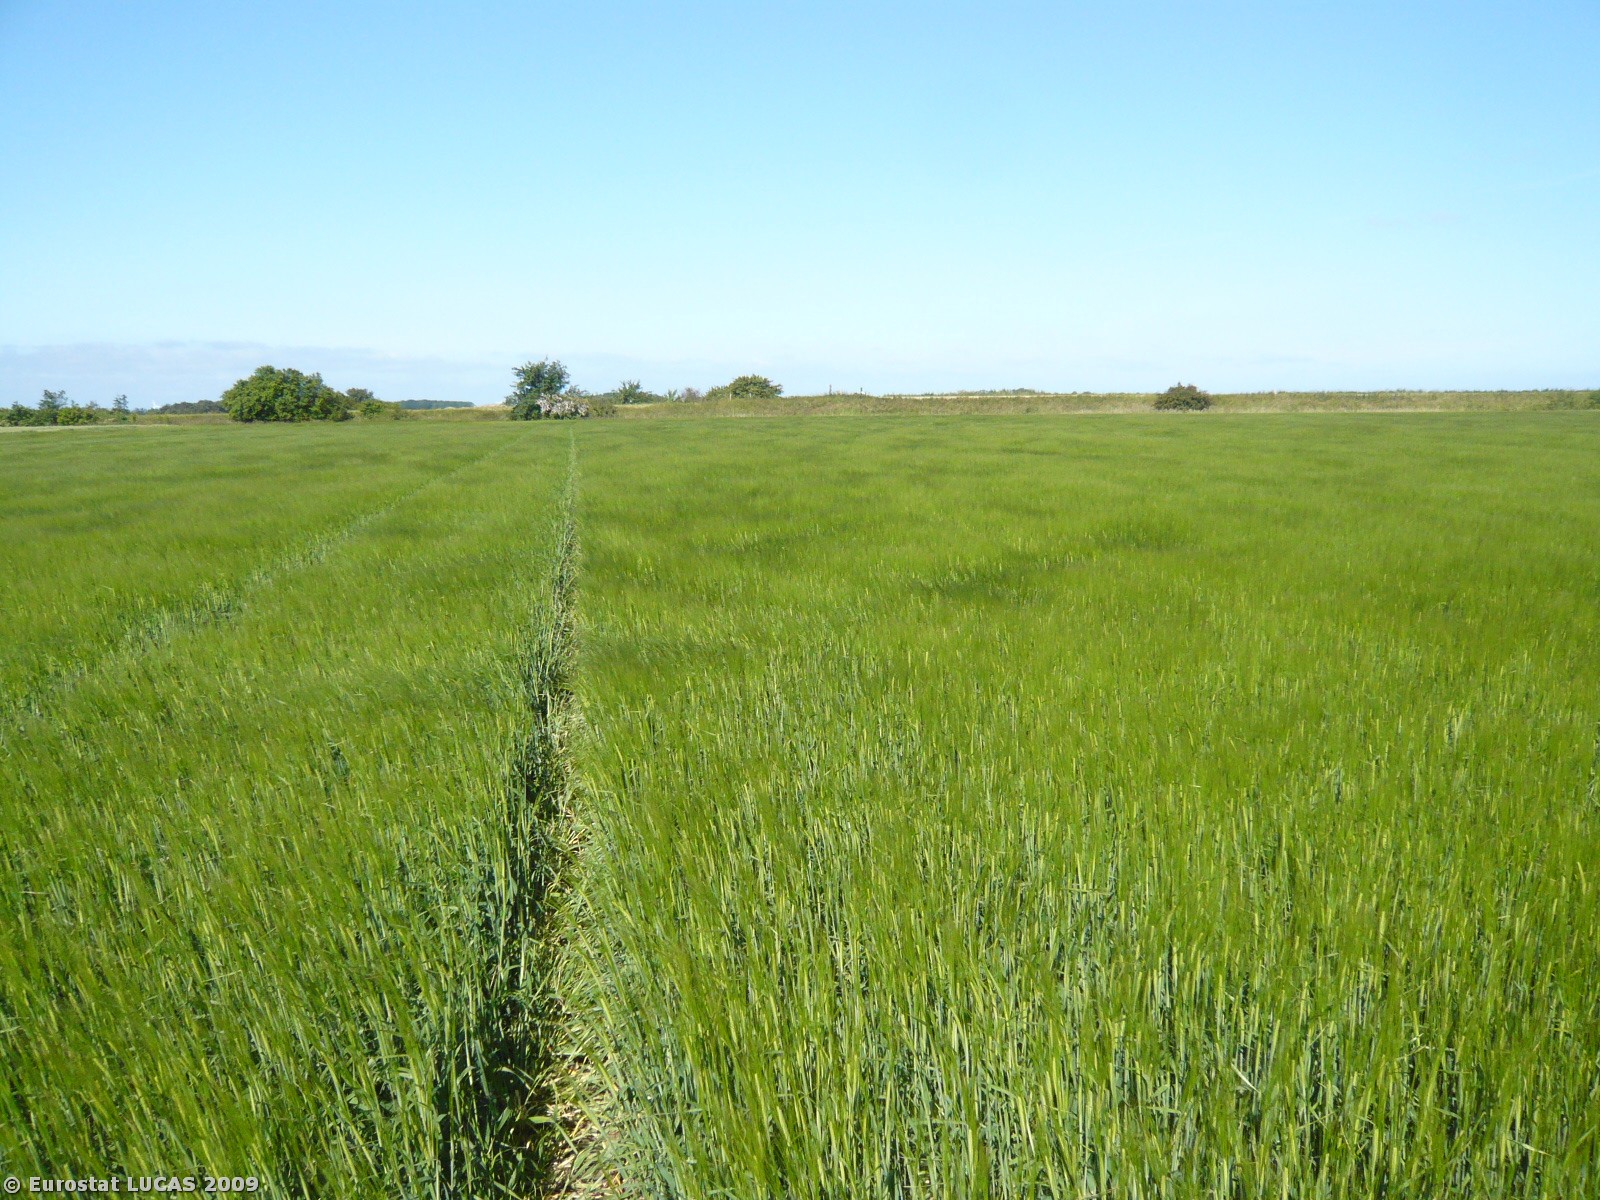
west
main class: Cropland
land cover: Barley
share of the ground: > 75 %
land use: Agriculture (excluding fallow land and kitchen gardens)
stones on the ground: < 10 %
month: June
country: DK
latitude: 54.7991
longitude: 11.0725
